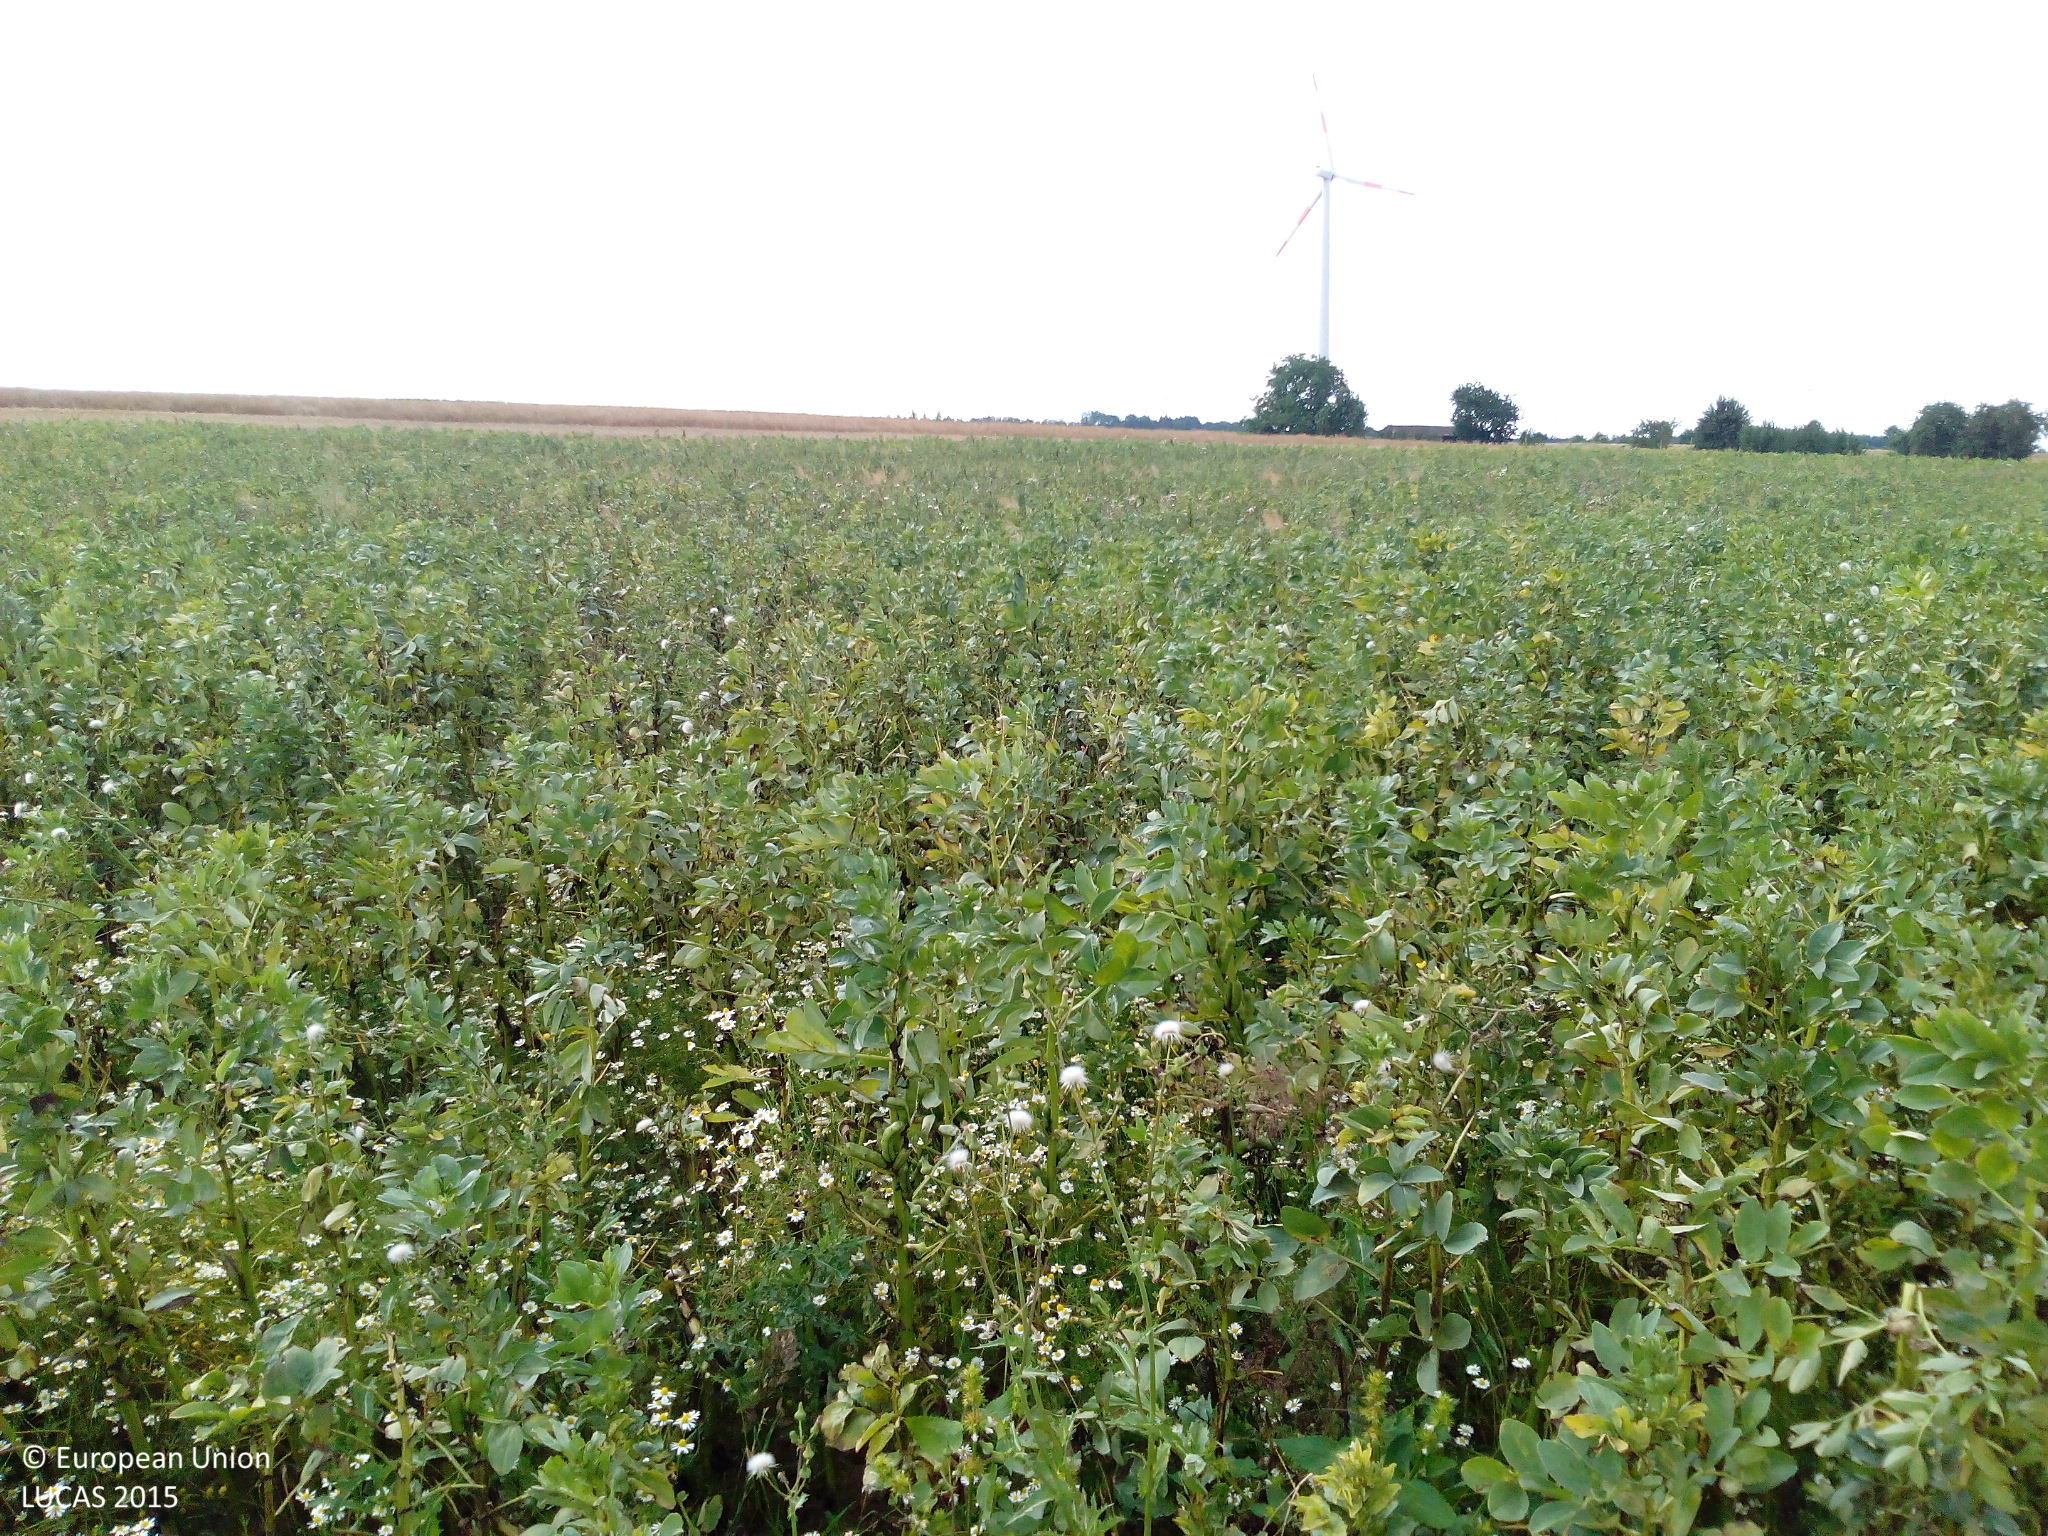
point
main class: Cropland
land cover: Dry pulses
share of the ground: > 75 %
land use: Agriculture (excluding fallow land and kitchen gardens)
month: July
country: DE
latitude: 51.5305
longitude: 9.2939
